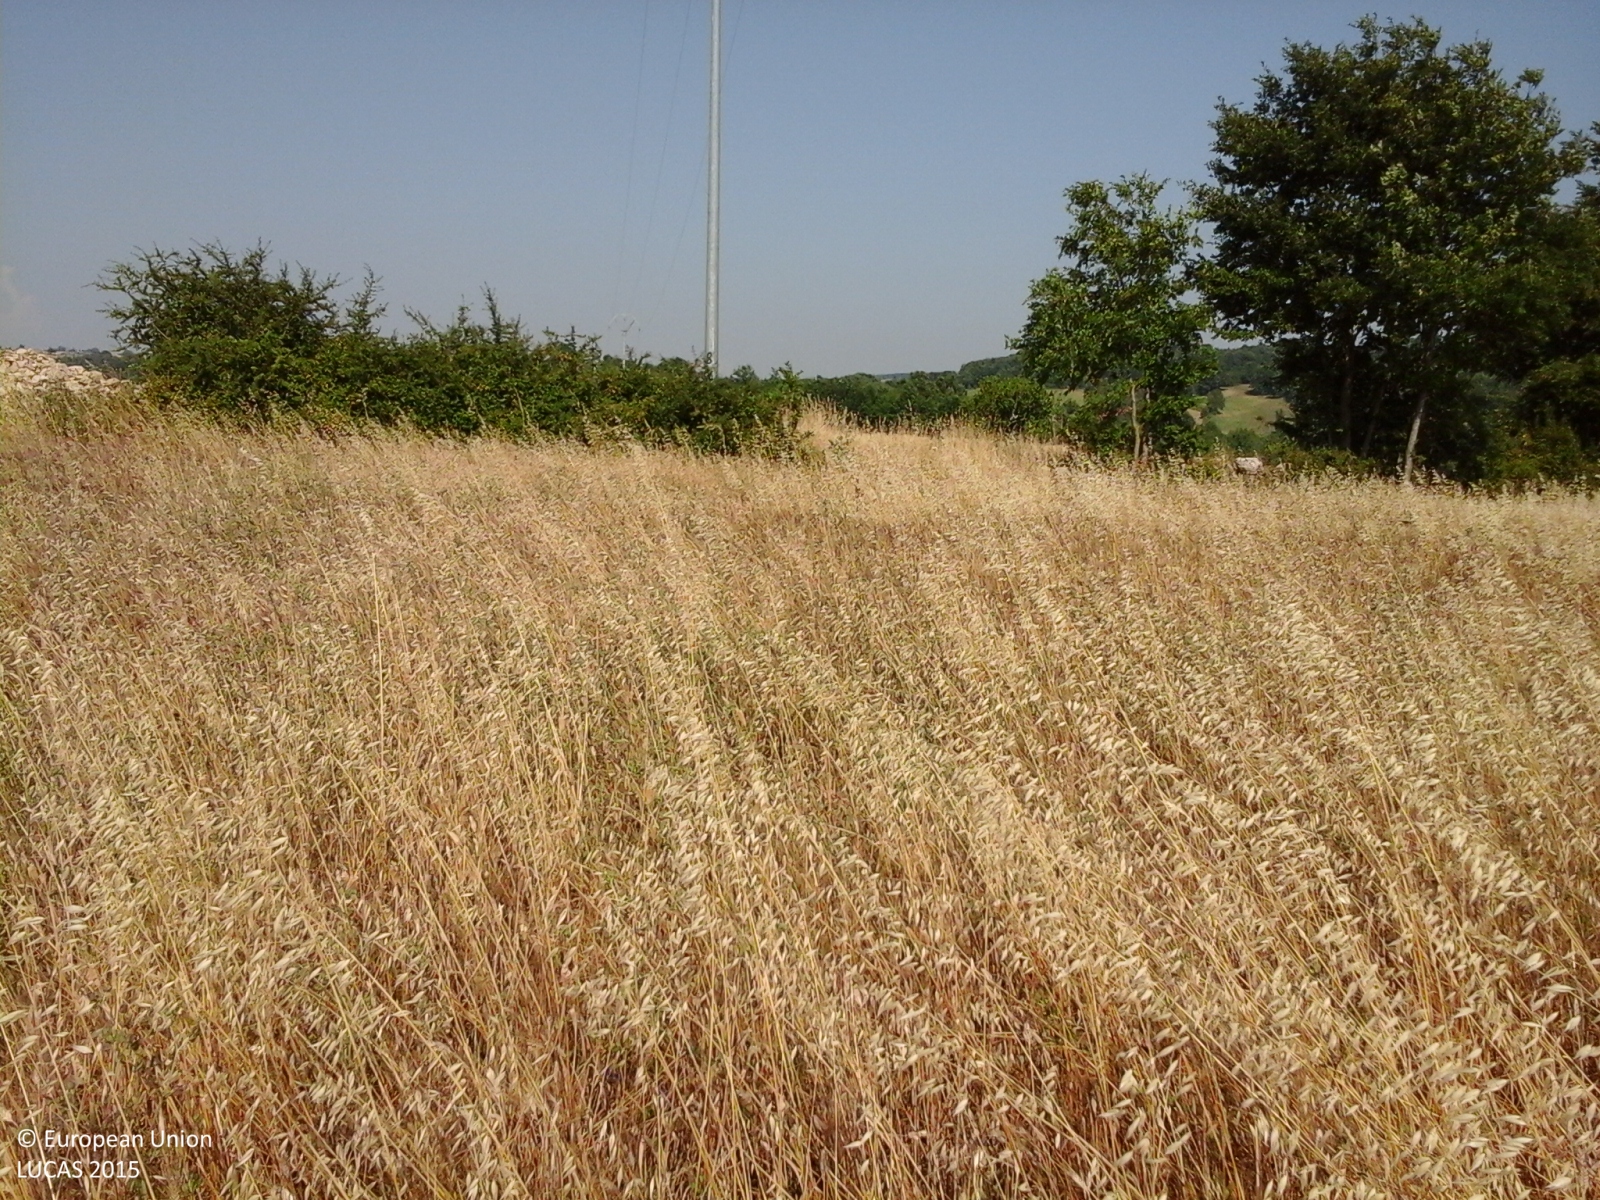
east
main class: Cropland
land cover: Durum wheat
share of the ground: > 75 %
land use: Agriculture (excluding fallow land and kitchen gardens)
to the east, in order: Durum wheat; Abandoned hedges; Electric lines; Paved roads, cycling and walking lanes; Barley; Spontaneously vegetated surfaces; Abandoned hedges; Spontaneously vegetated surfaces
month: July
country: IT
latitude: 41.4225
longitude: 14.7094
